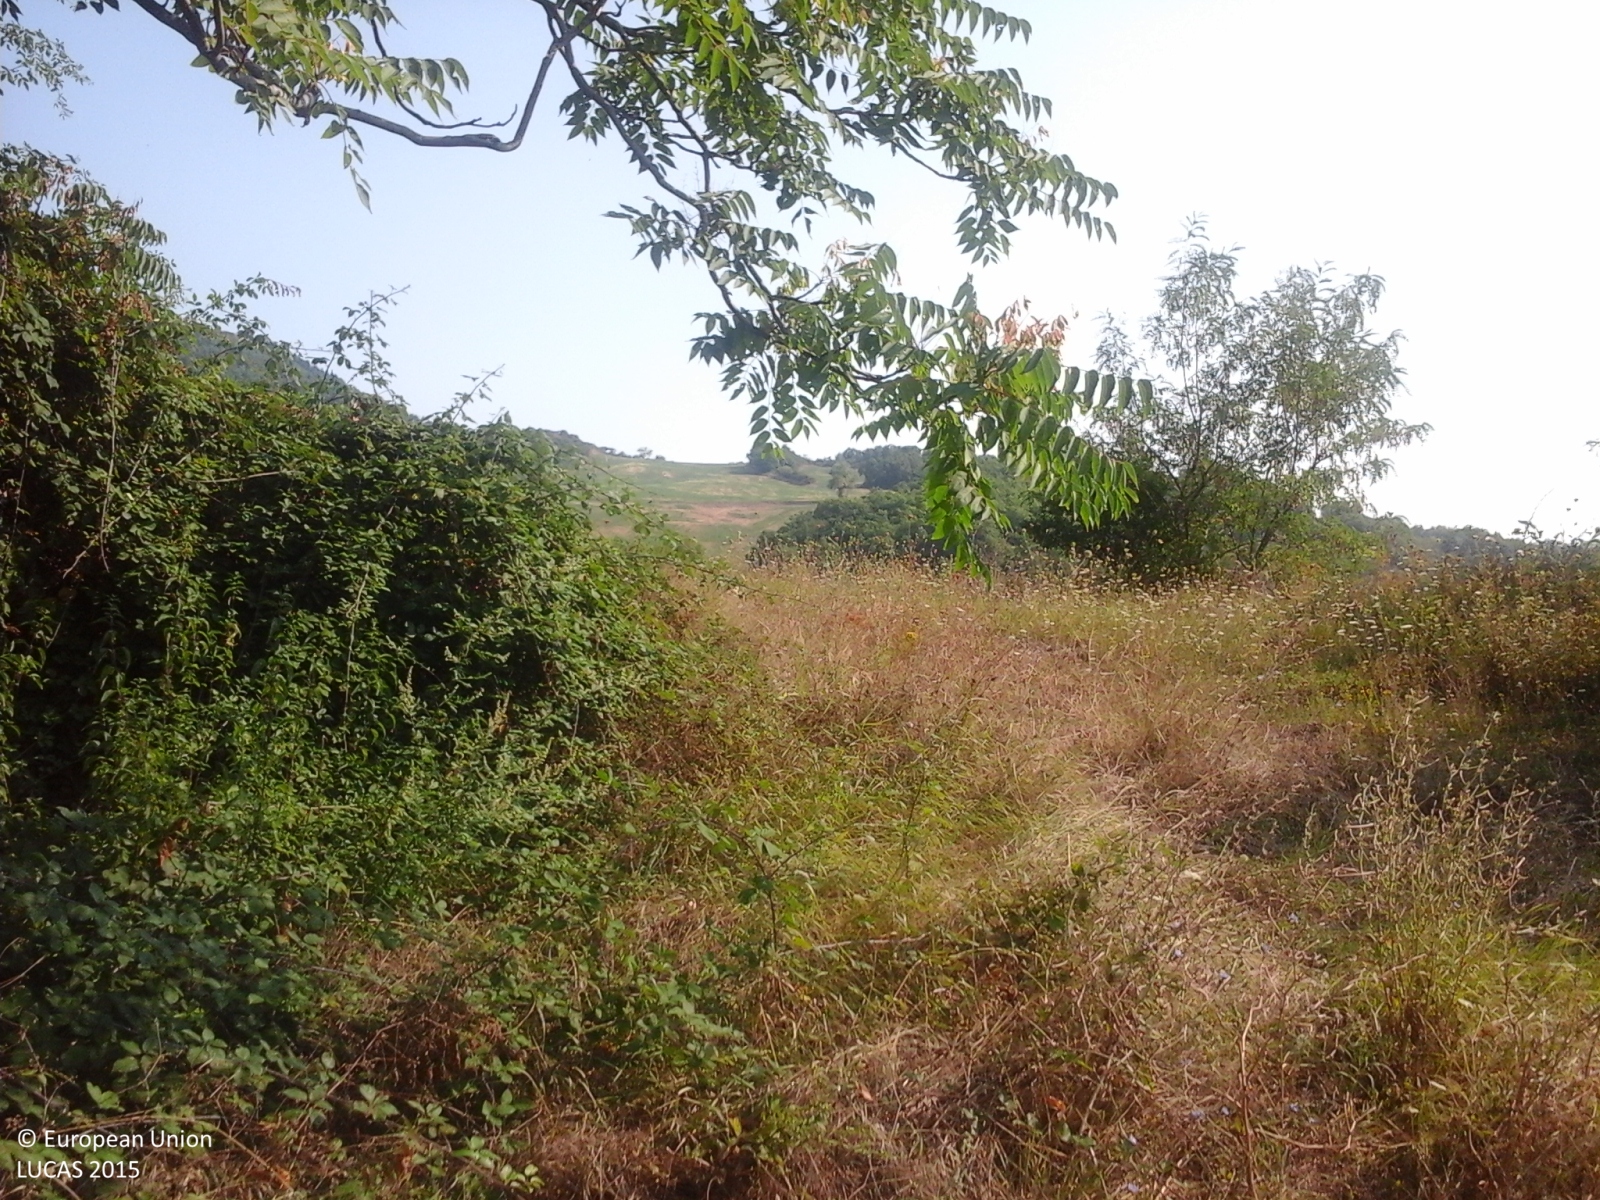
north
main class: Woodland
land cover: Broadleaved woodland
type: thermophilous deciduous forest
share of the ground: > 75 %
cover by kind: broadleaved forest trees 100 %
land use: Forestry
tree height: > 5 m
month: August
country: IT
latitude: 43.8171
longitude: 12.4185
